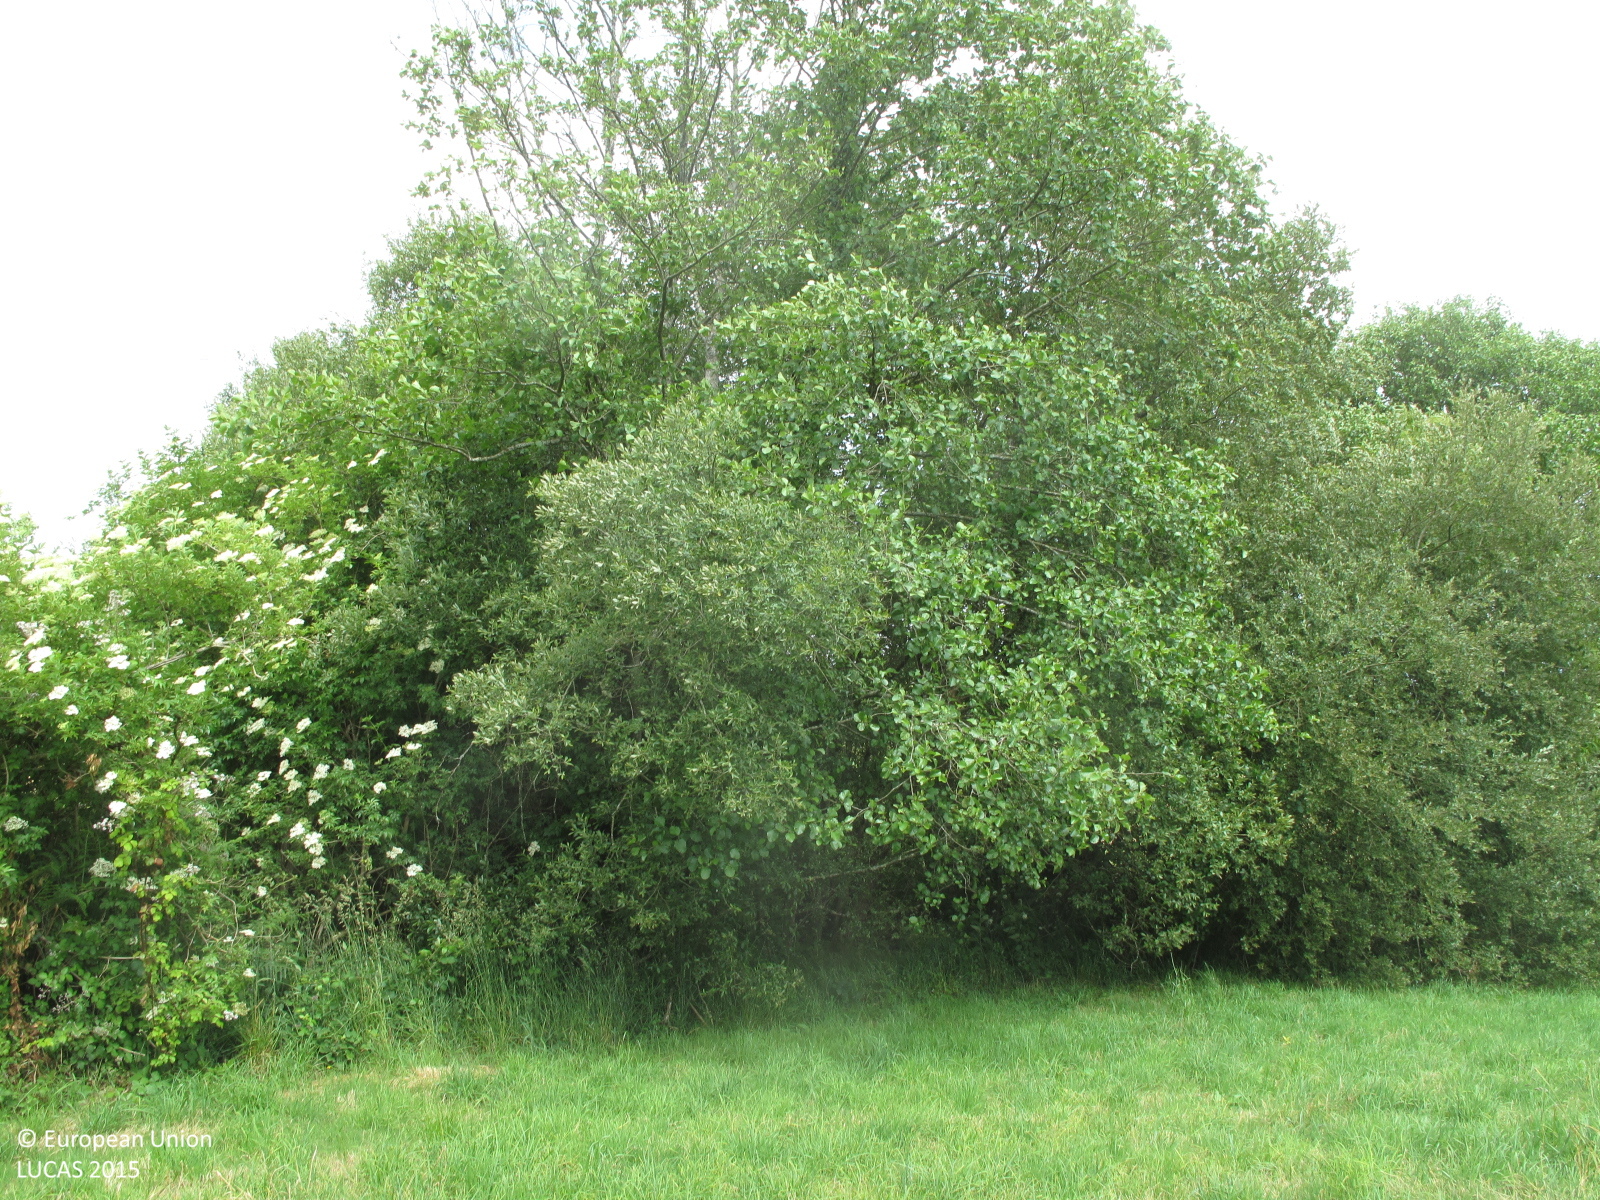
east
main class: Grassland
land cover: Grassland without tree/shrub cover
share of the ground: > 75 %
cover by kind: herbaceous plants 100 %
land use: Agriculture (excluding fallow land and kitchen gardens)
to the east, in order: Grassland without tree/shrub cover; Broadleaved woodland; Rivers and streams; Broadleaved woodland; Shrubland with sparse tree cover; Grassland without tree/shrub cover; Electric lines; Grassland without tree/shrub cover; Maize; Grassland without tree/shrub cover; Spontaneously vegetated surfaces; Other fresh vegetables; Spontaneously vegetated surfaces; Single bushes/trees; Grassland without tree/shrub cover; Electric lines; Paved roads, cycling and walking lanes; Broadleaved woodland; Other fresh vegetables; Artificial constructions in urban areas
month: June
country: ES
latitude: 43.0288
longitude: -8.5526
